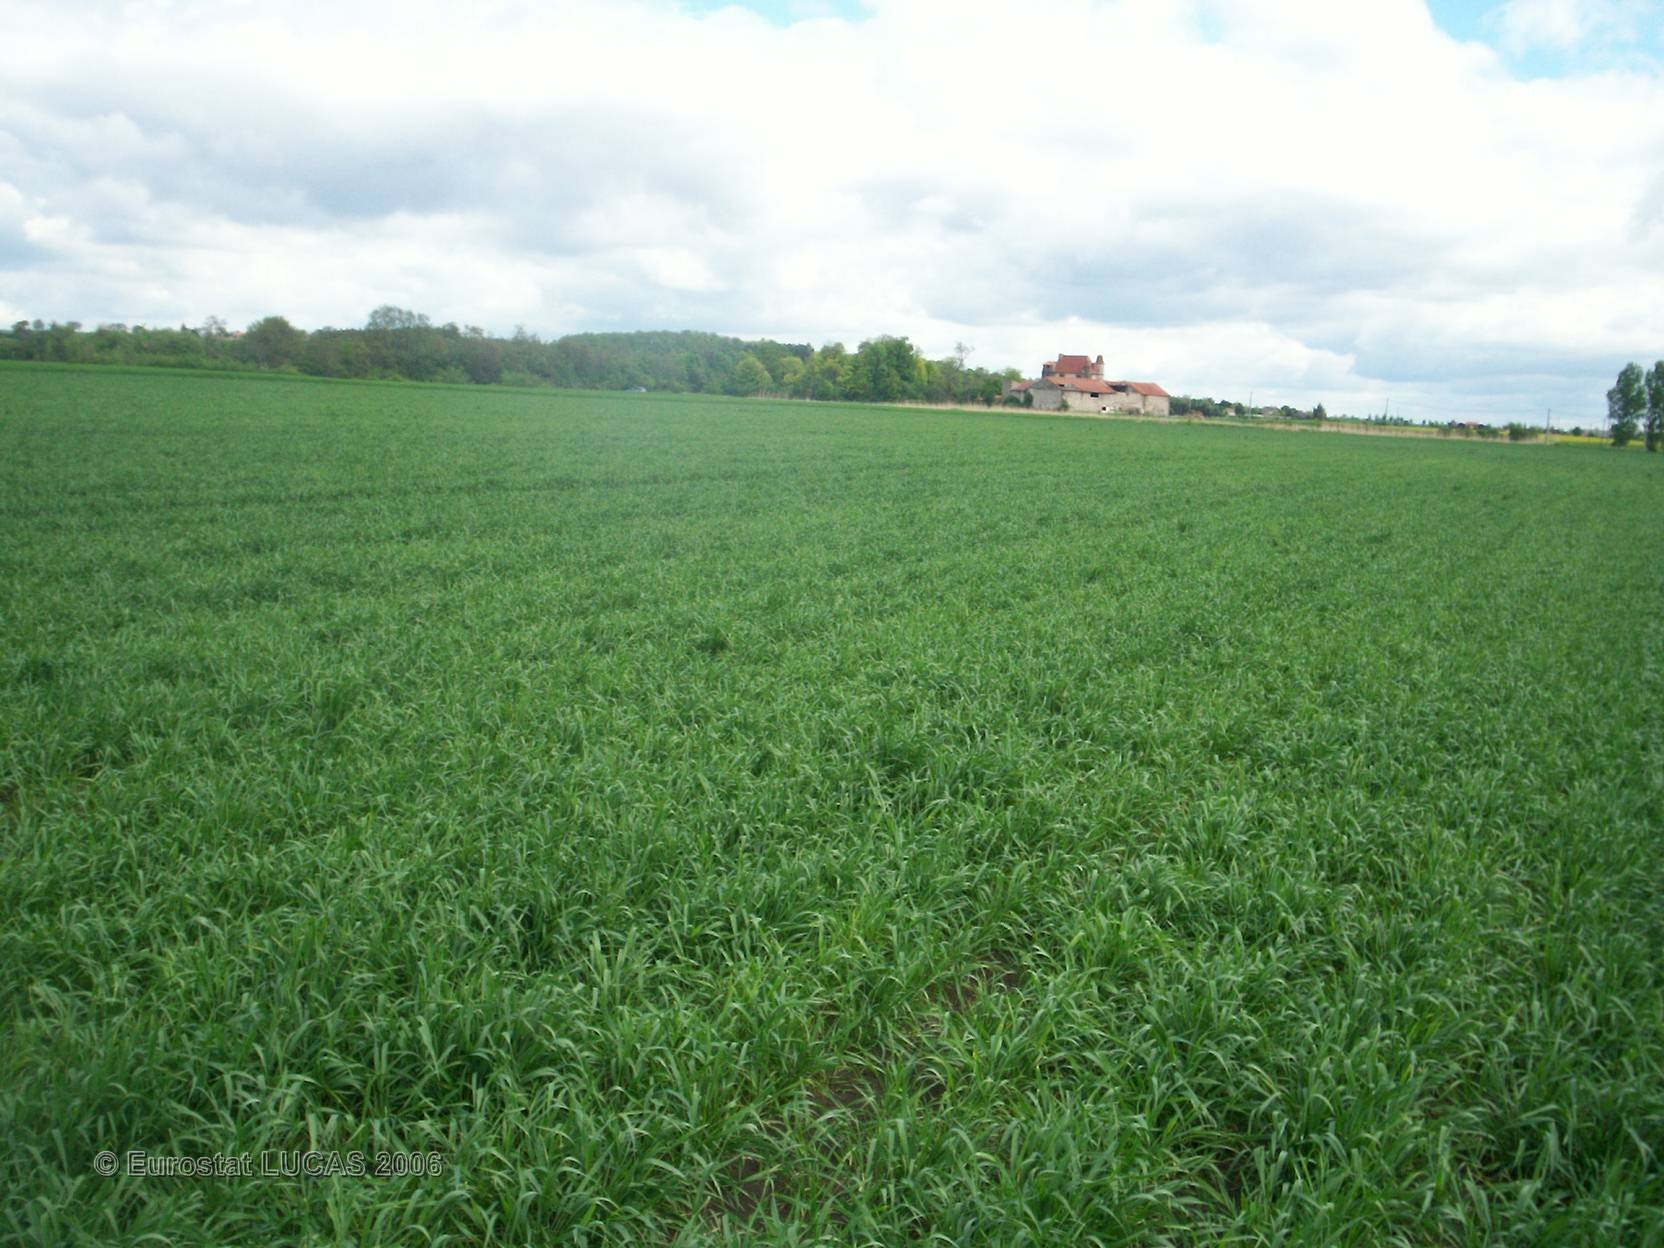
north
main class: Cropland
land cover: Barley
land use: Agriculture (excluding fallow land and kitchen gardens)
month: May
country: FR
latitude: 45.9148
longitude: 3.1535
